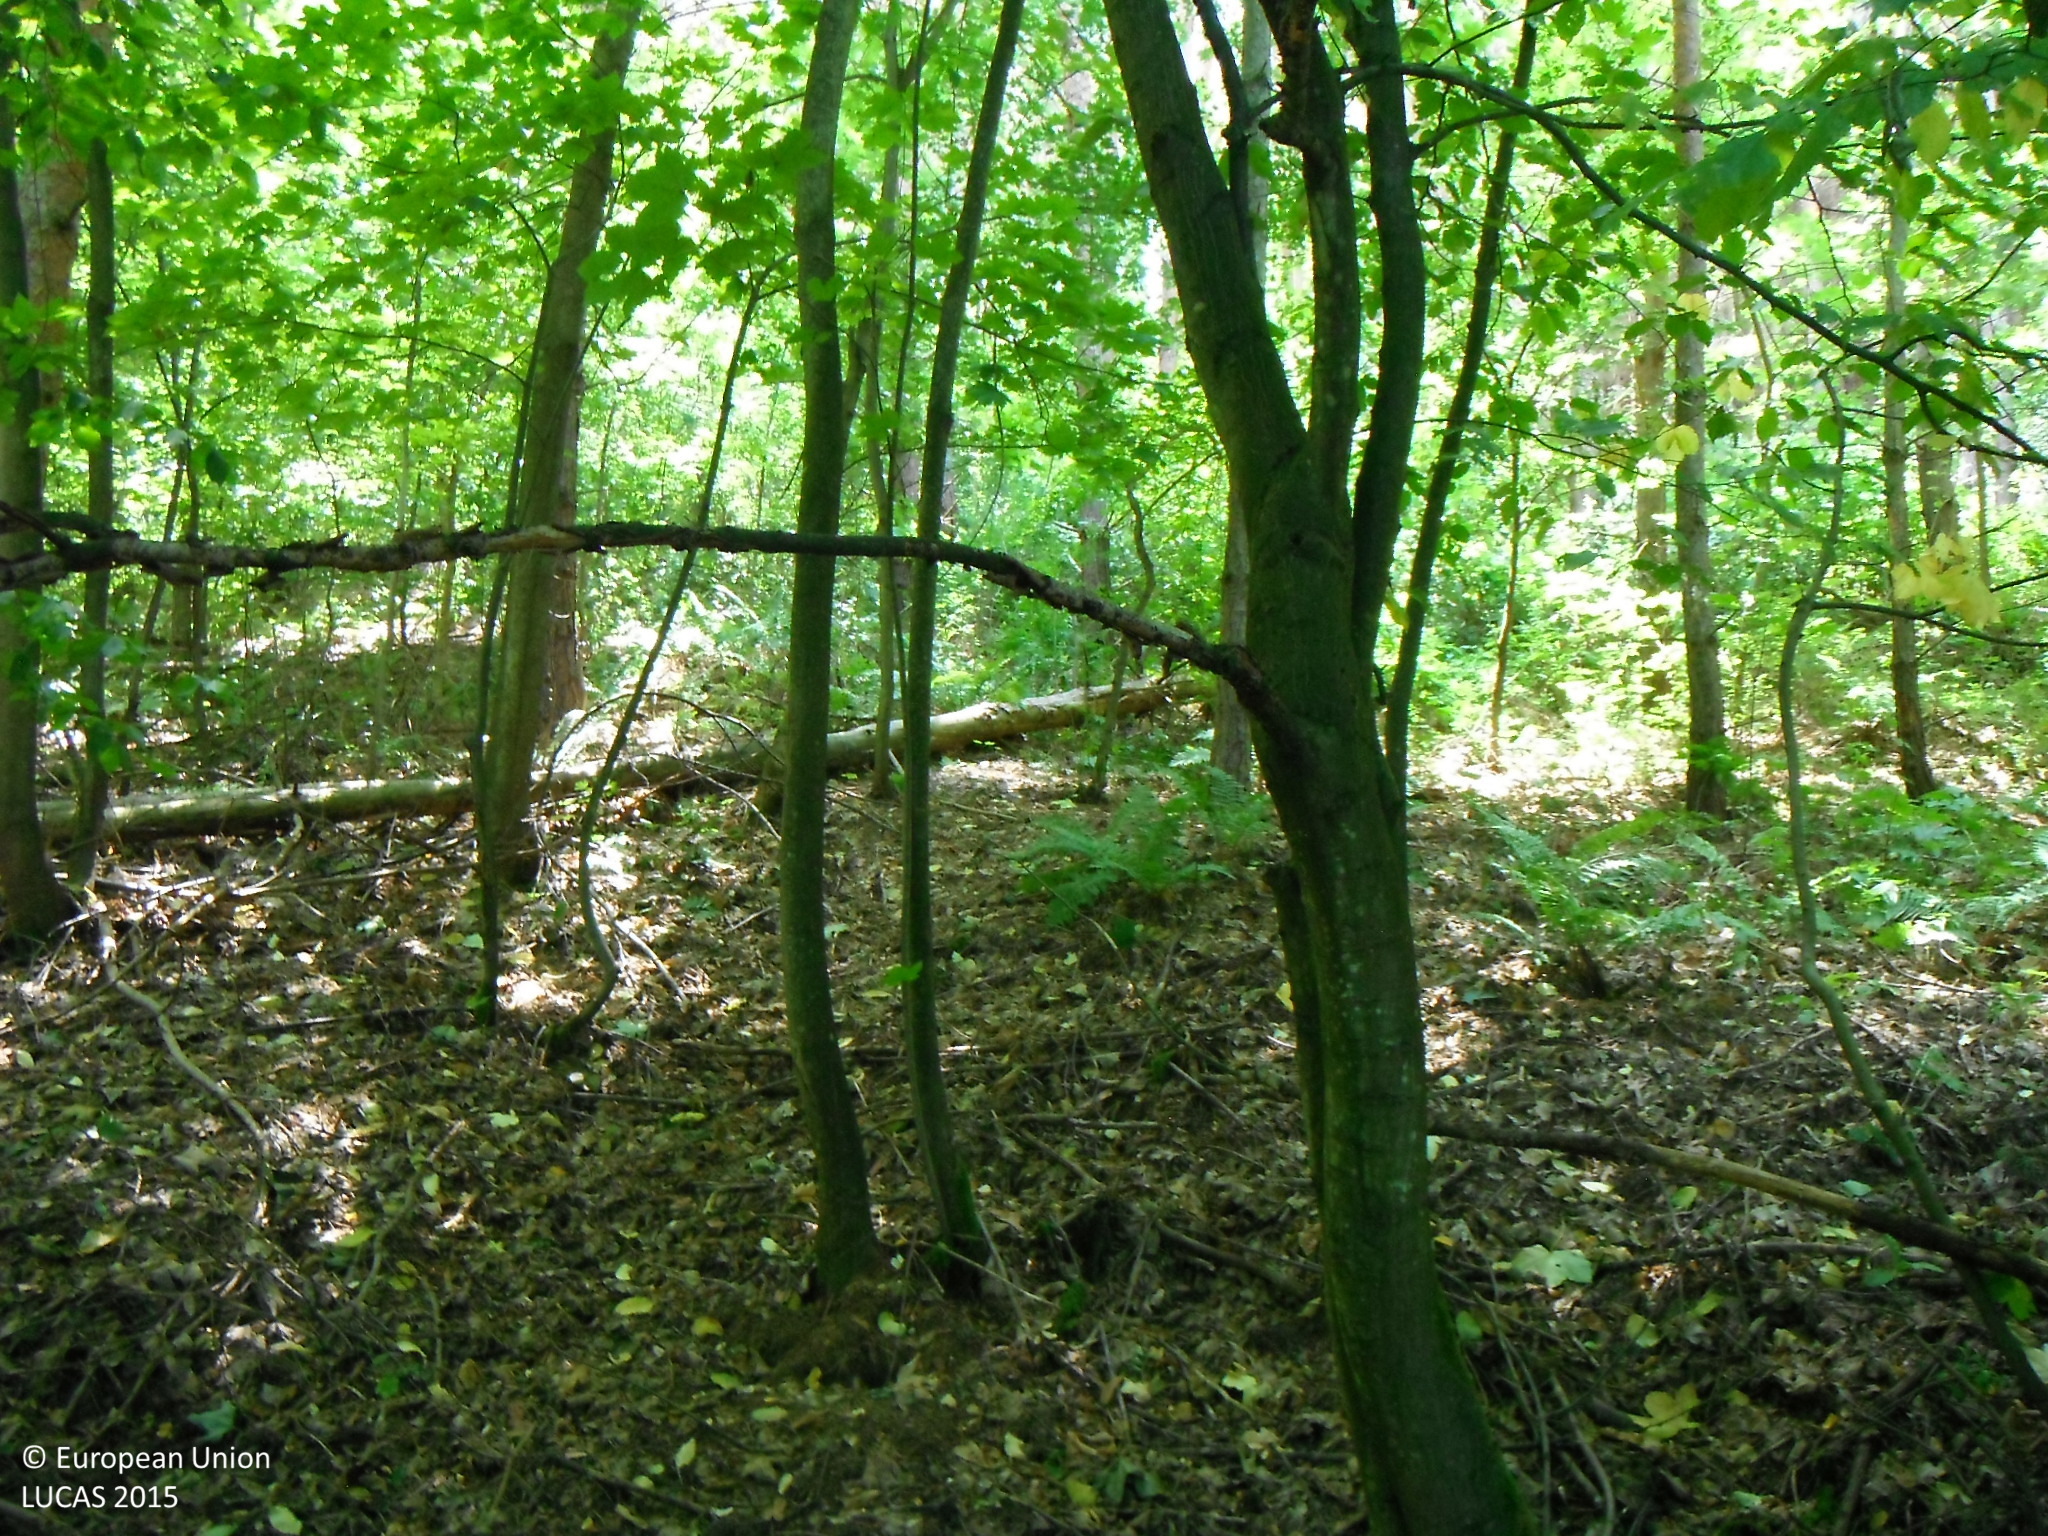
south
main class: Woodland
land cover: Broadleaved woodland
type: mesophytic deciduous forest
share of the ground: > 75 %
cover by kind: broadleaved forest trees 100 %
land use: Forestry
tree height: > 5 m
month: July
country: SK
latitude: 48.2005
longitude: 20.0257
